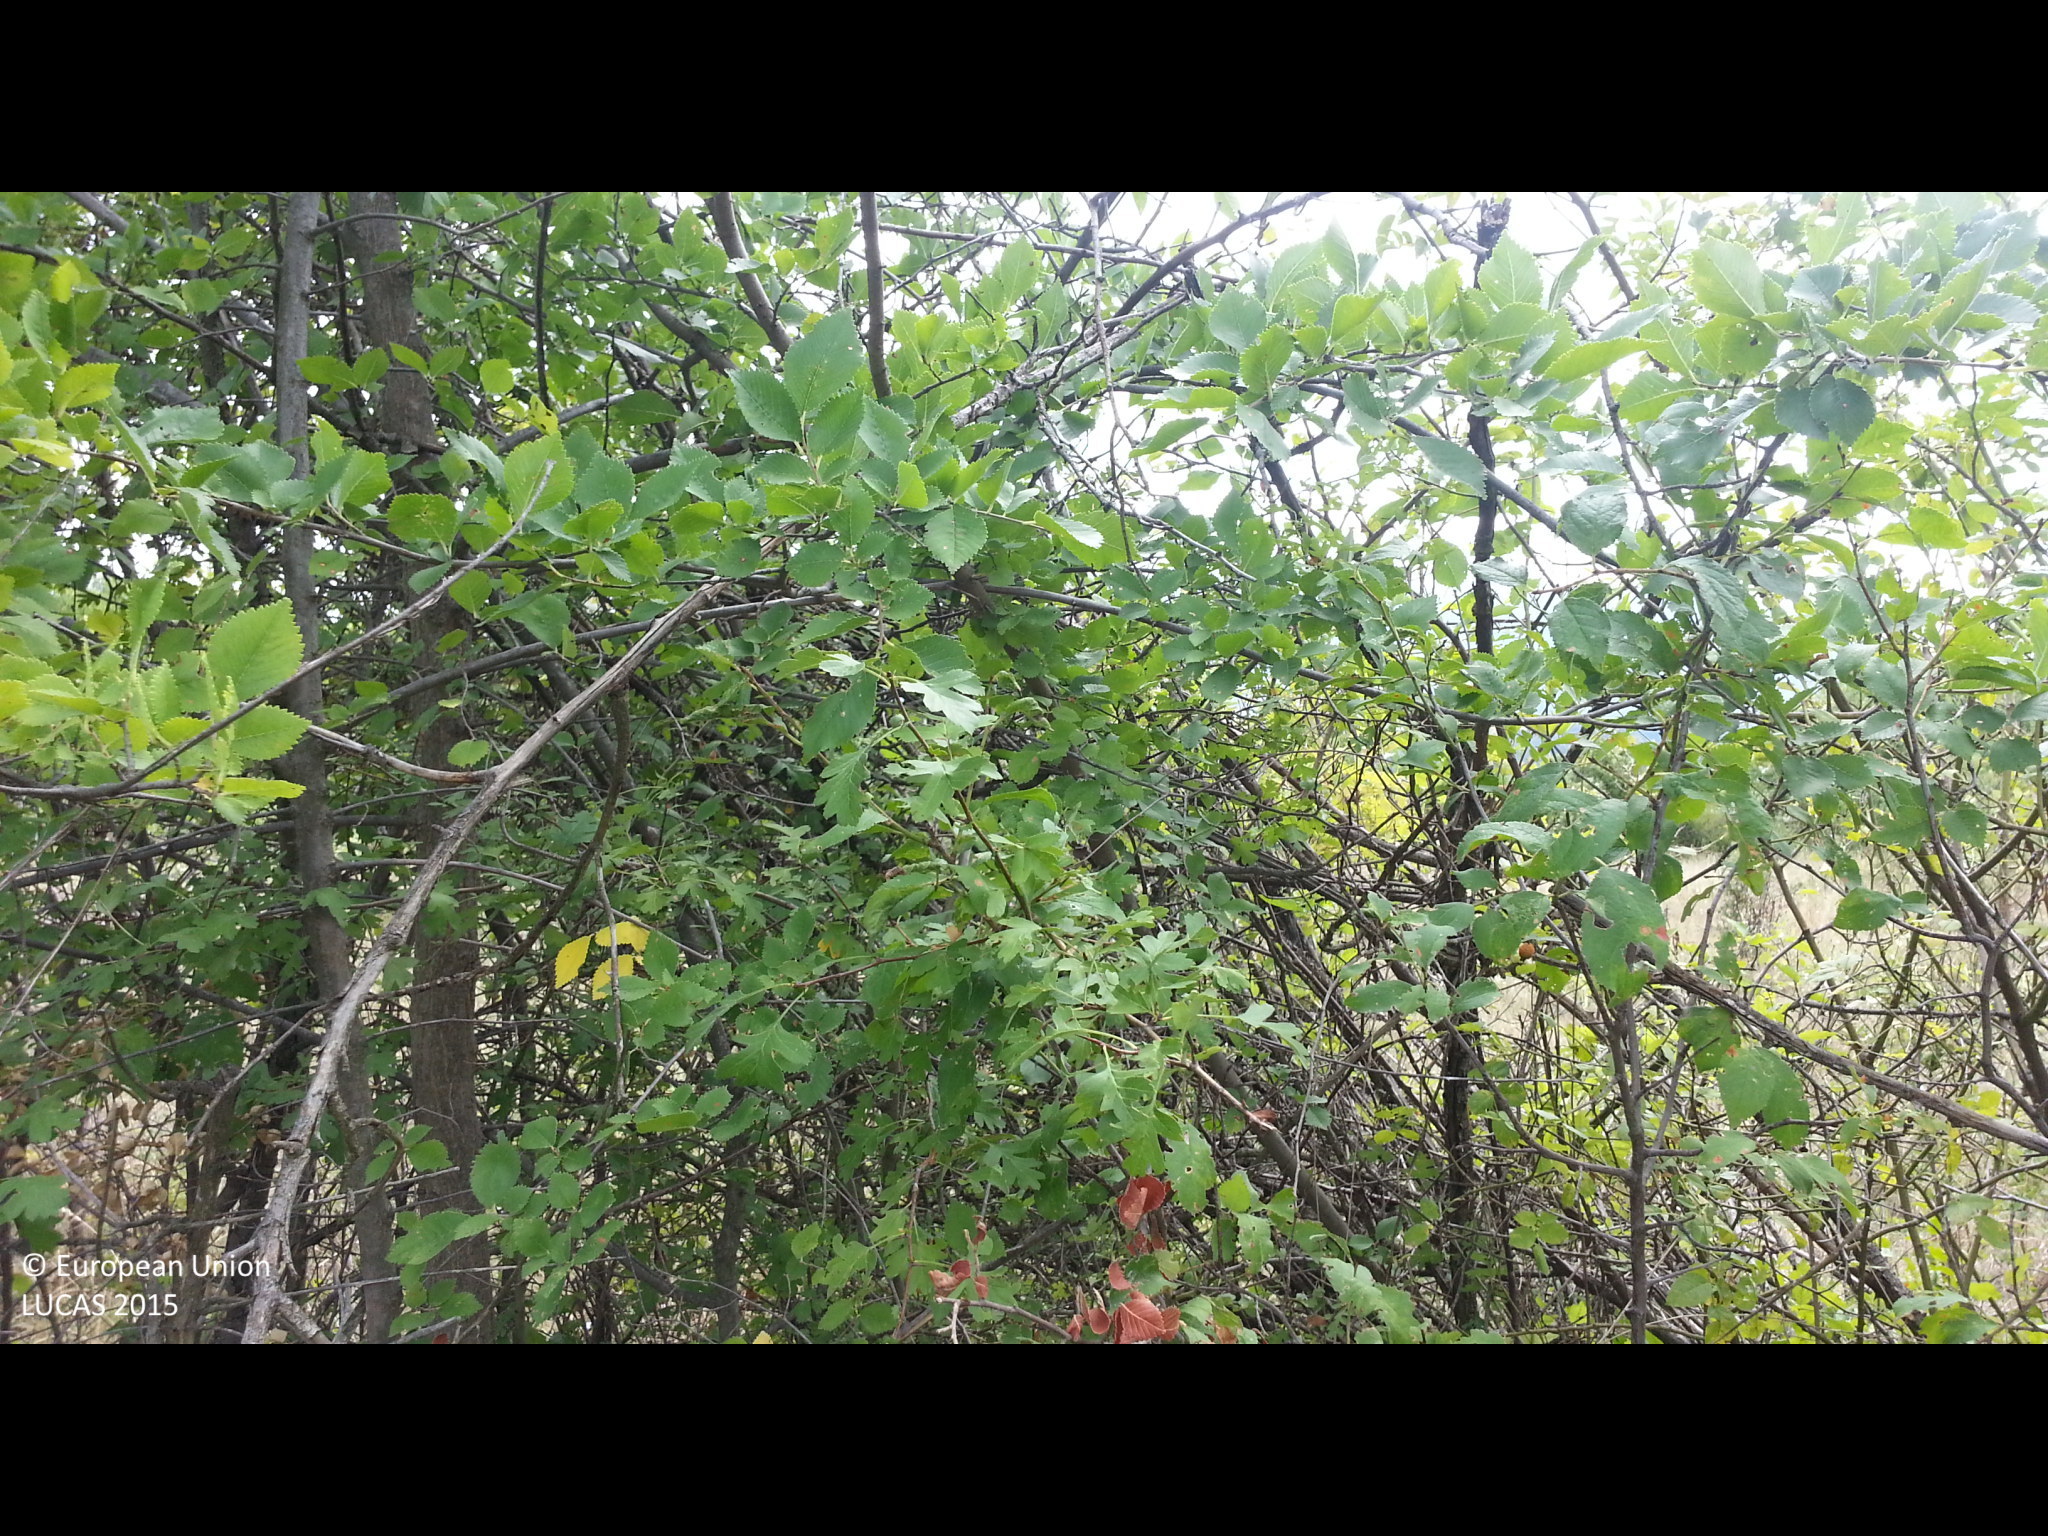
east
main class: Shrubland
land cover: Shrubland with sparse tree cover
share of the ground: > 75 %
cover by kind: herbaceous plants 60 %, shrubs 35 %, broadleaved forest trees 5 %
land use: Abandoned areas
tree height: < 5 m
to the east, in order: Shrubland with sparse tree cover; Abandoned hedges; Grassland with sparse tree/shrub cover; Artificial constructions in urban areas; Shrubland with sparse tree cover; Broadleaved woodland; Shrubland with sparse tree cover; Tracks; Grassland with sparse tree/shrub cover
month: August
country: BG
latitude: 42.2583
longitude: 23.0819
